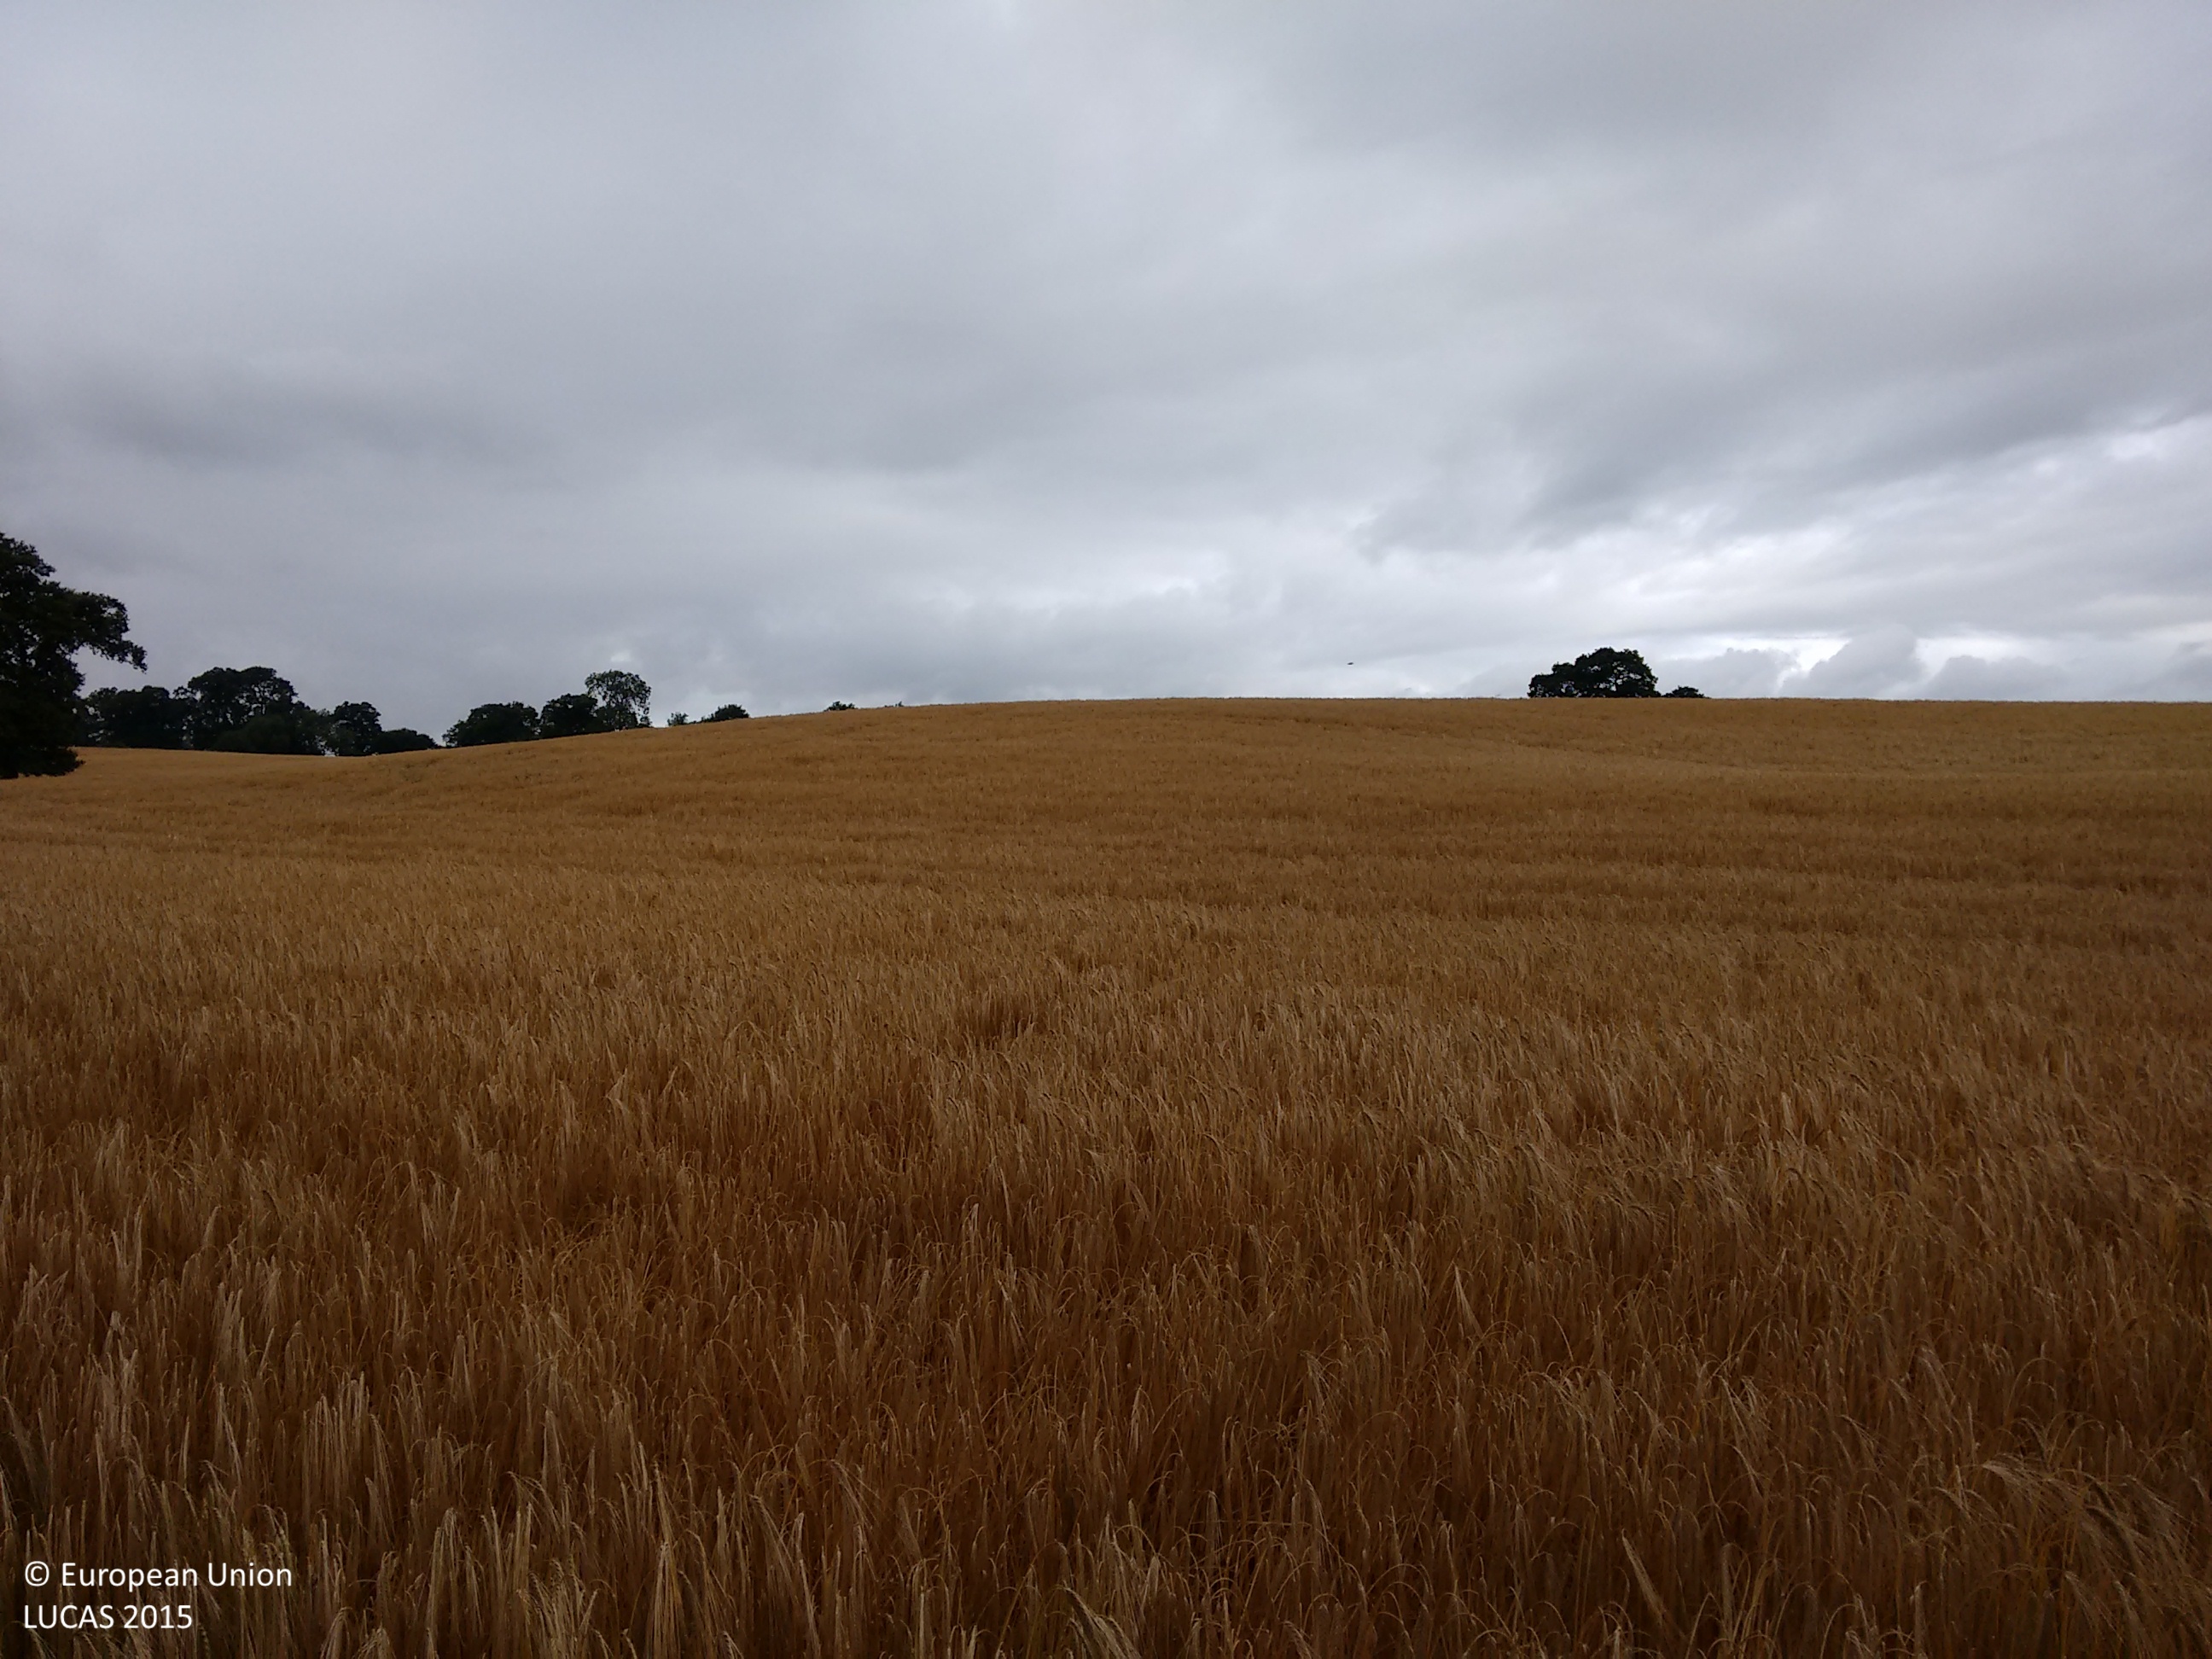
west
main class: Cropland
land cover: Barley
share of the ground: > 75 %
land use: Agriculture (excluding fallow land and kitchen gardens)
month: July
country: GB
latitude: 53.1918
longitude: -2.8080
